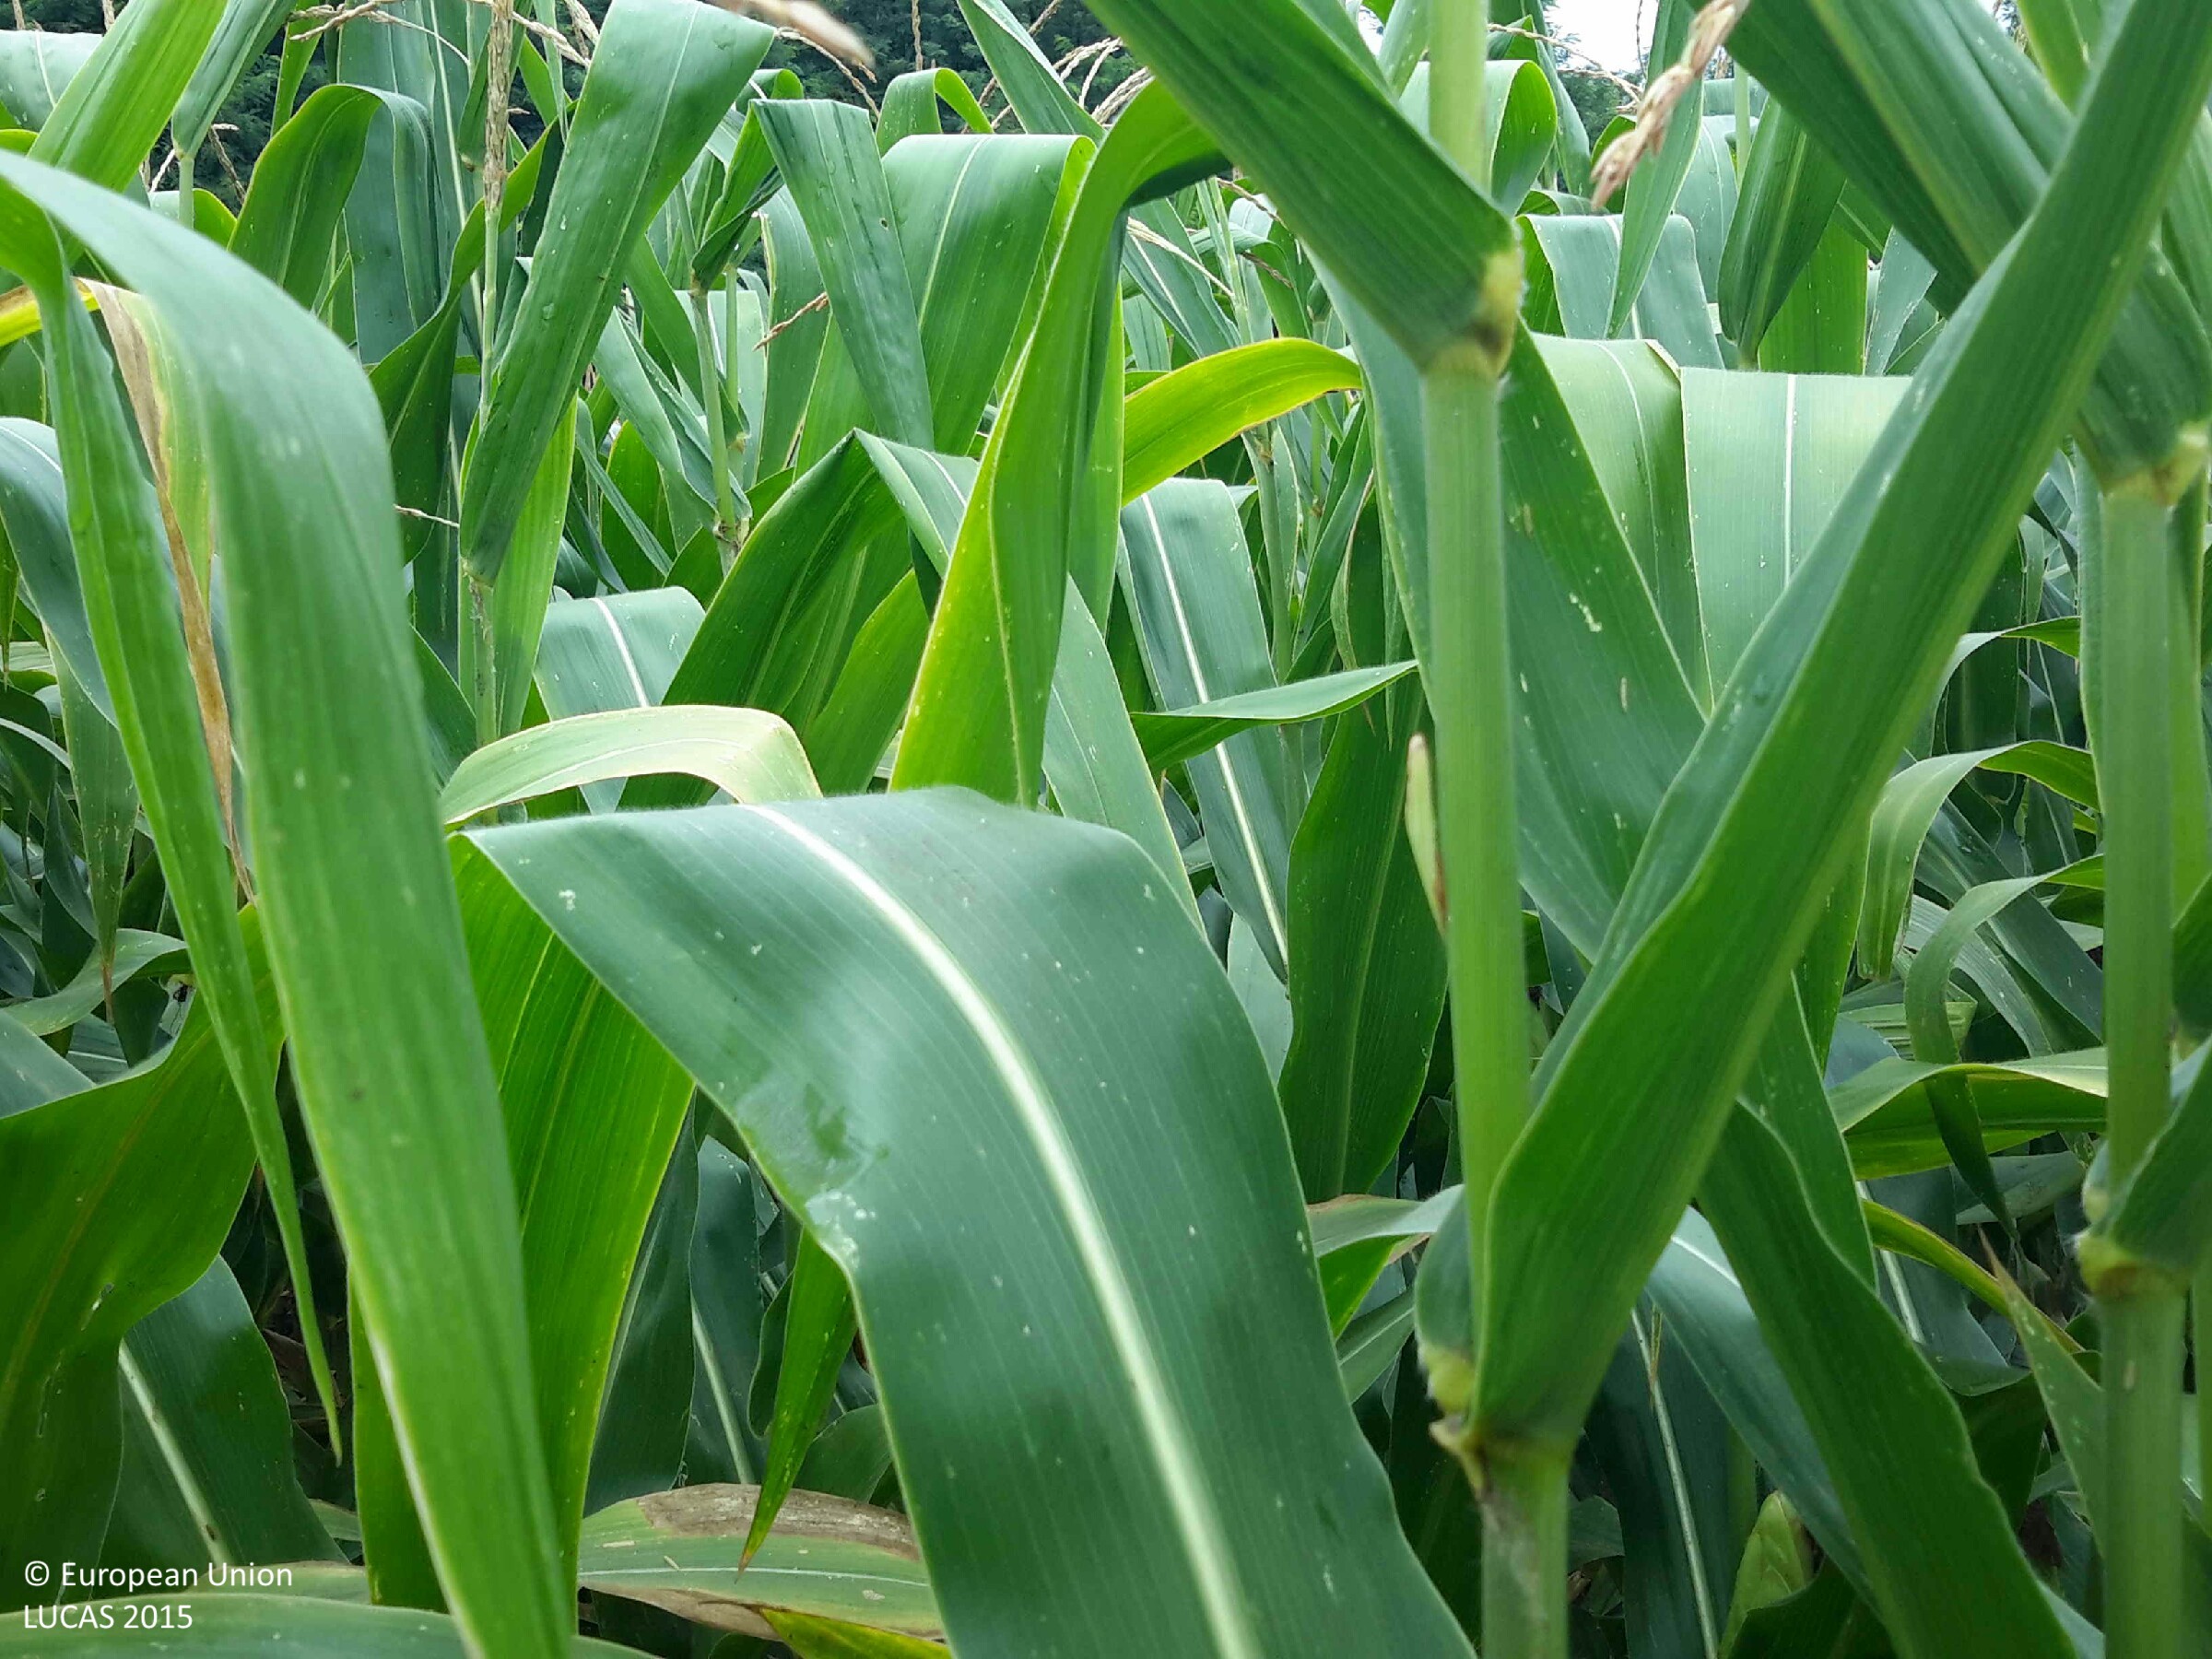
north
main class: Cropland
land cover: Maize
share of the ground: > 75 %
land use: Agriculture (excluding fallow land and kitchen gardens)
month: July
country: HU
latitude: 47.6029
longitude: 17.5504
